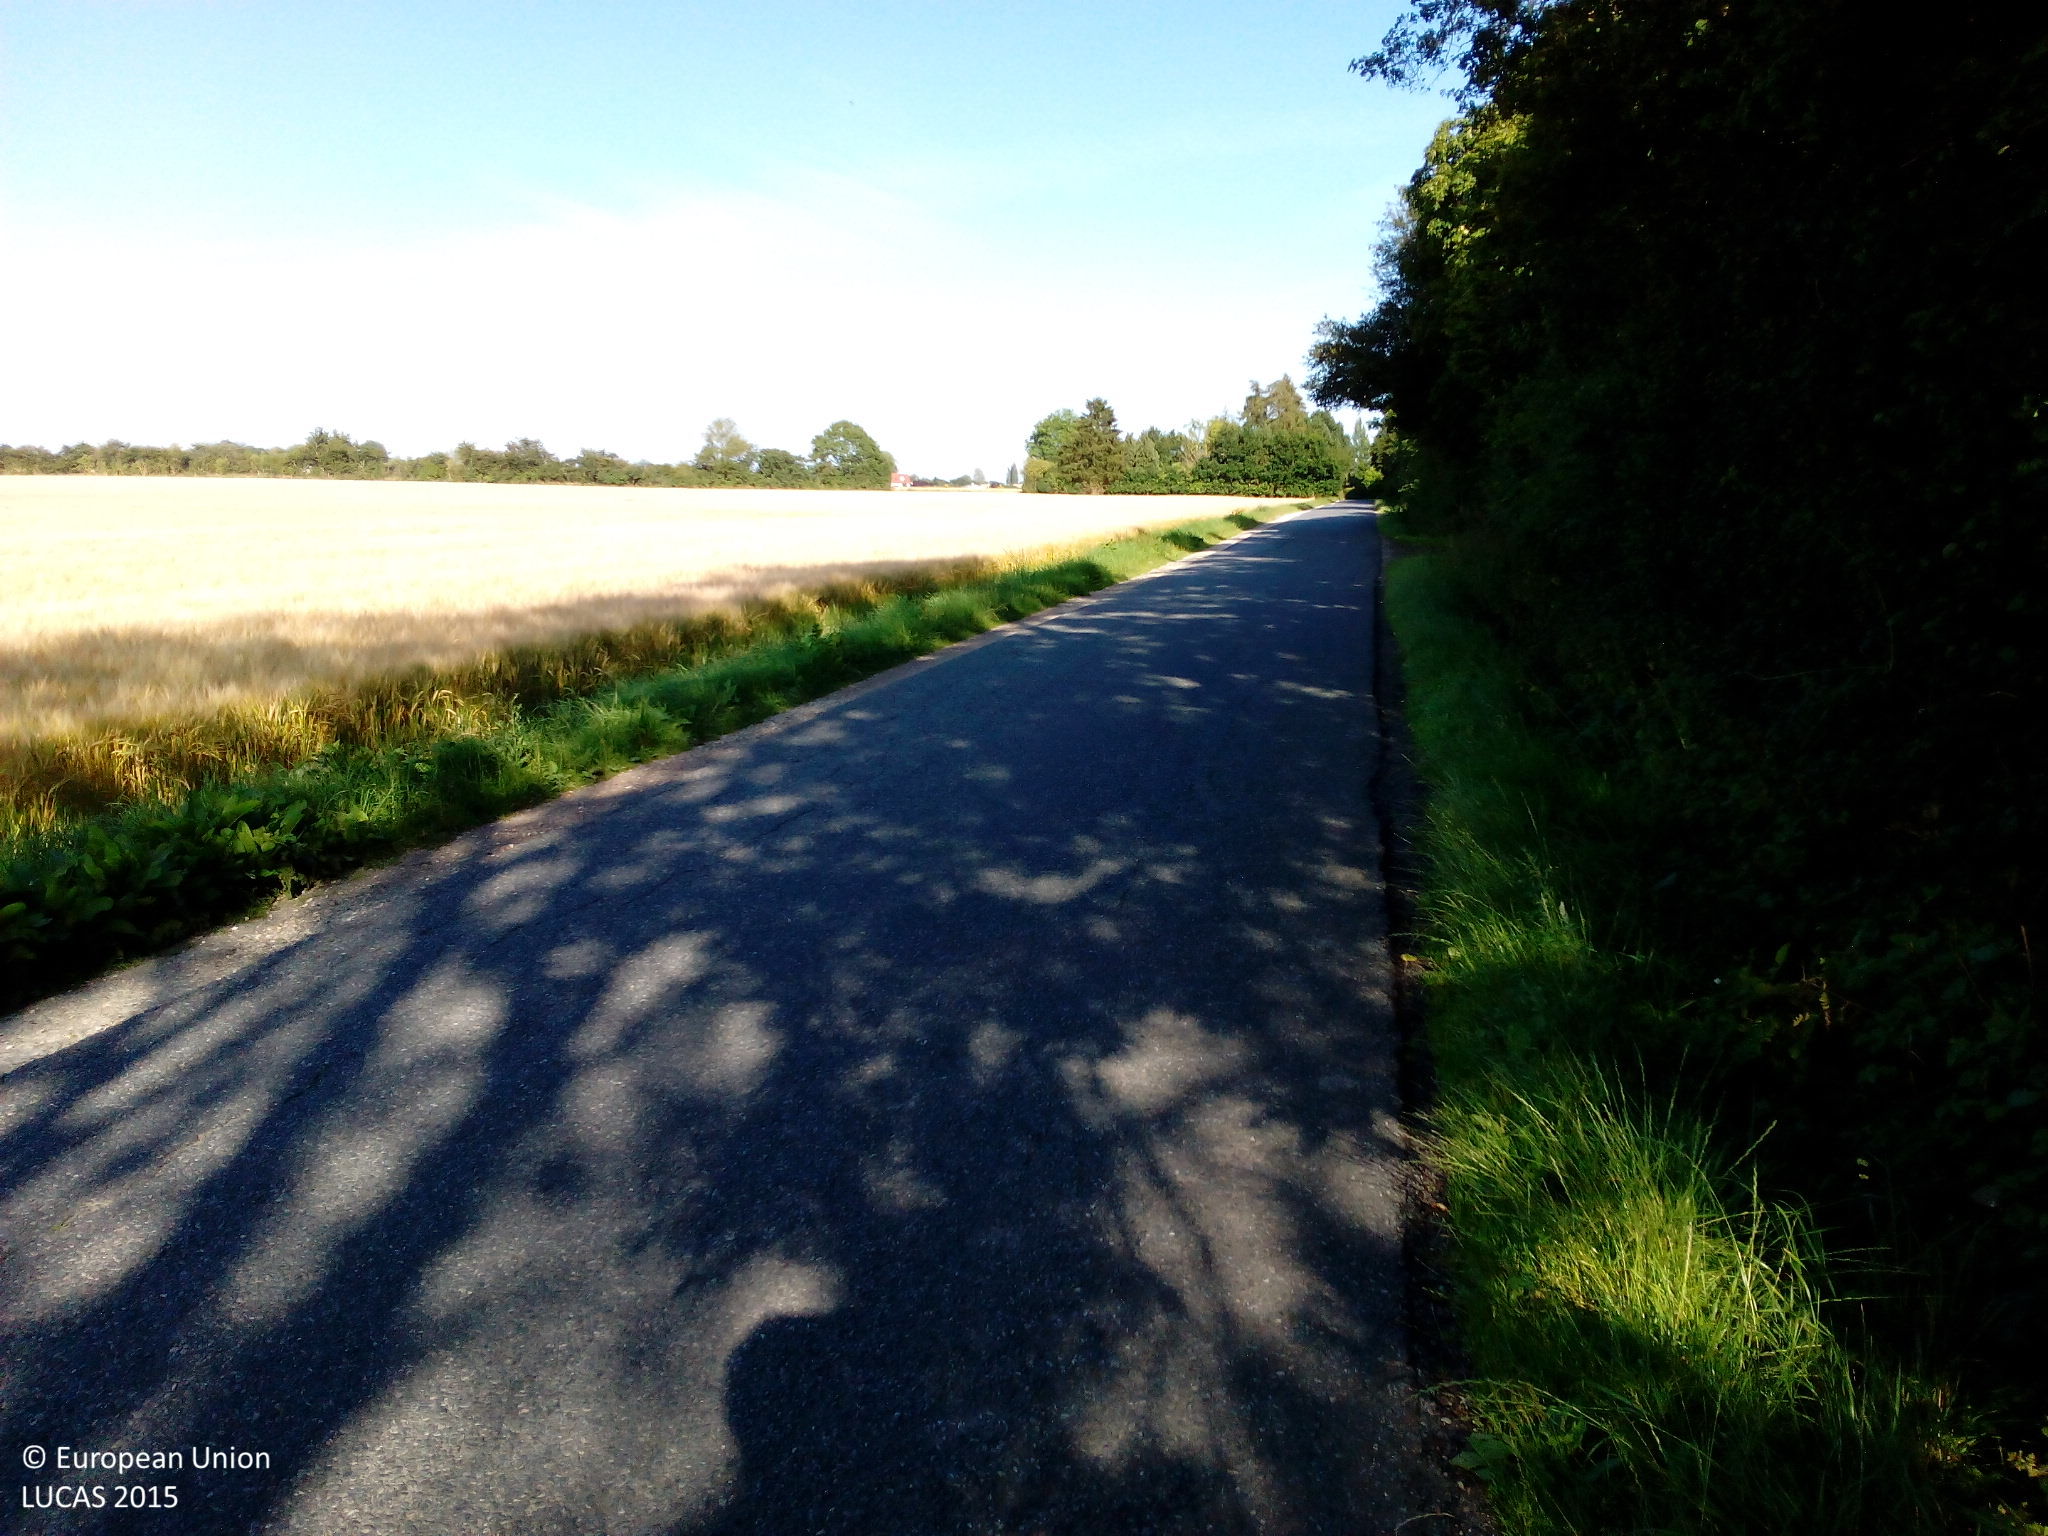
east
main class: Cropland
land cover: Common wheat
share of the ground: > 75 %
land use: Agriculture (excluding fallow land and kitchen gardens)
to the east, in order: Common wheat; Artificial constructions in urban areas; Grass margins; Common wheat
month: August
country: DK
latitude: 55.2510
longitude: 12.2480
